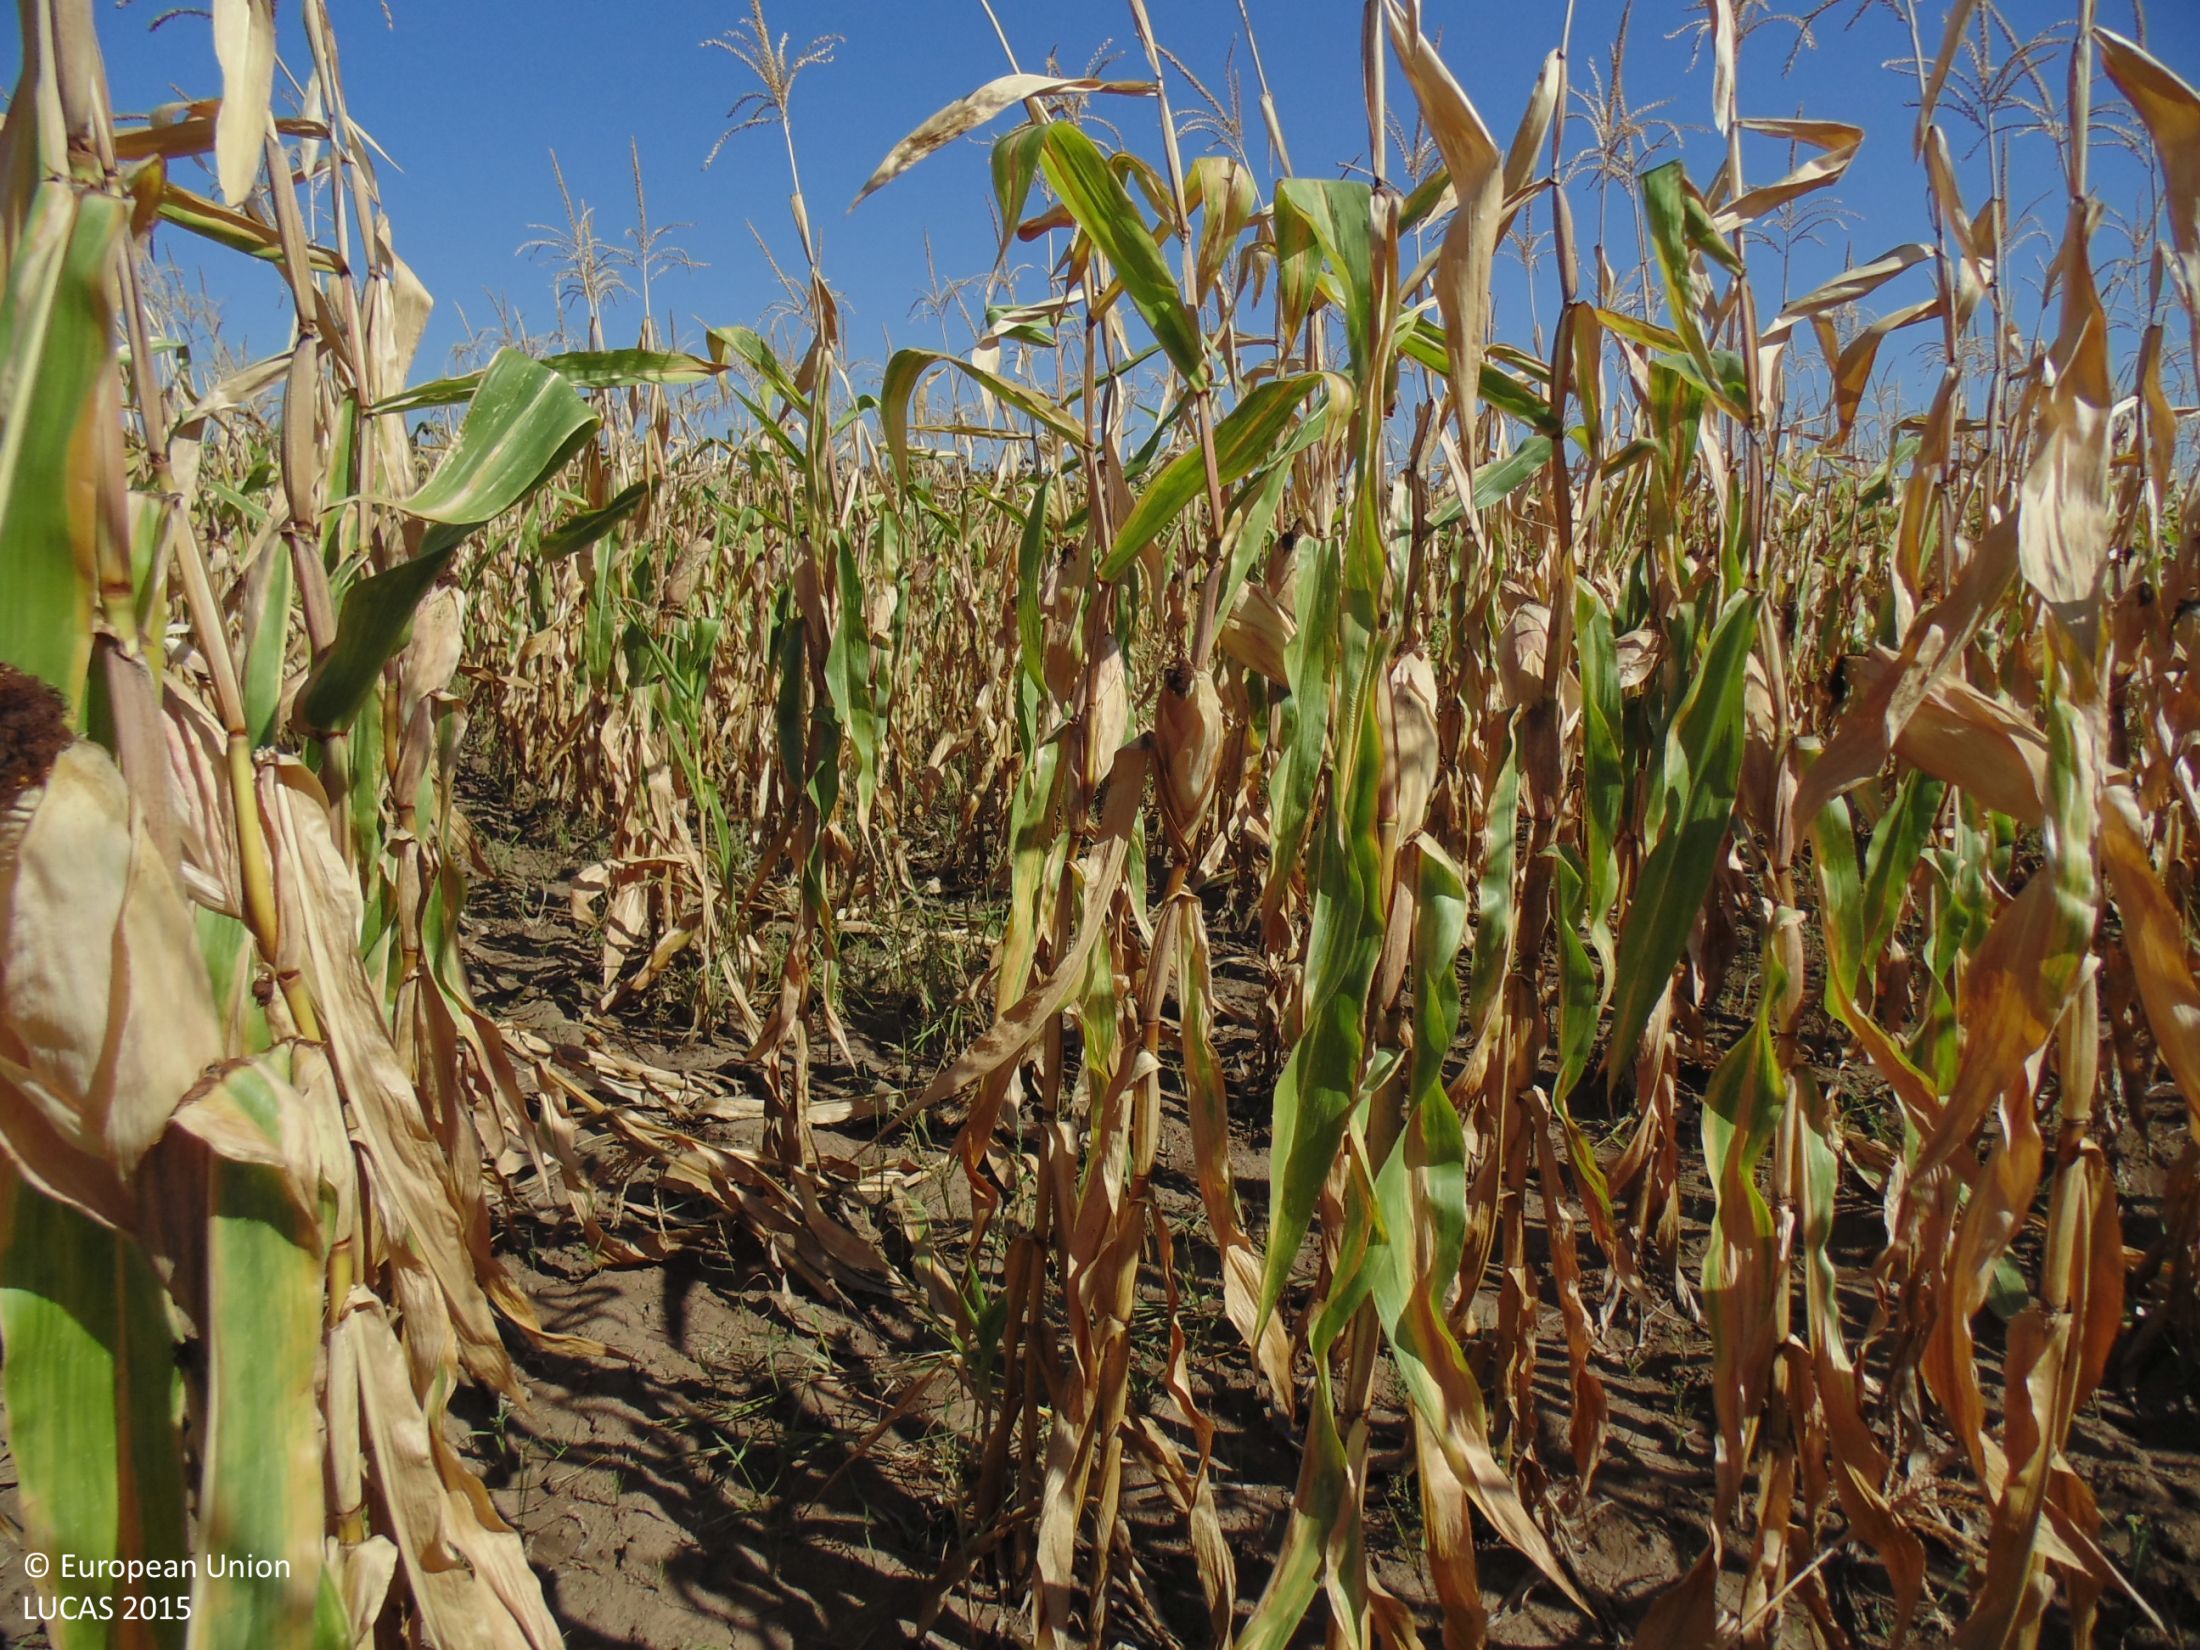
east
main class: Cropland
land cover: Maize
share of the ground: > 75 %
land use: Agriculture (excluding fallow land and kitchen gardens)
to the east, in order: Maize; Grass margins; Sunflower; Grass margins; Maize
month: September
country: BG
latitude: 43.8938
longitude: 26.9898
